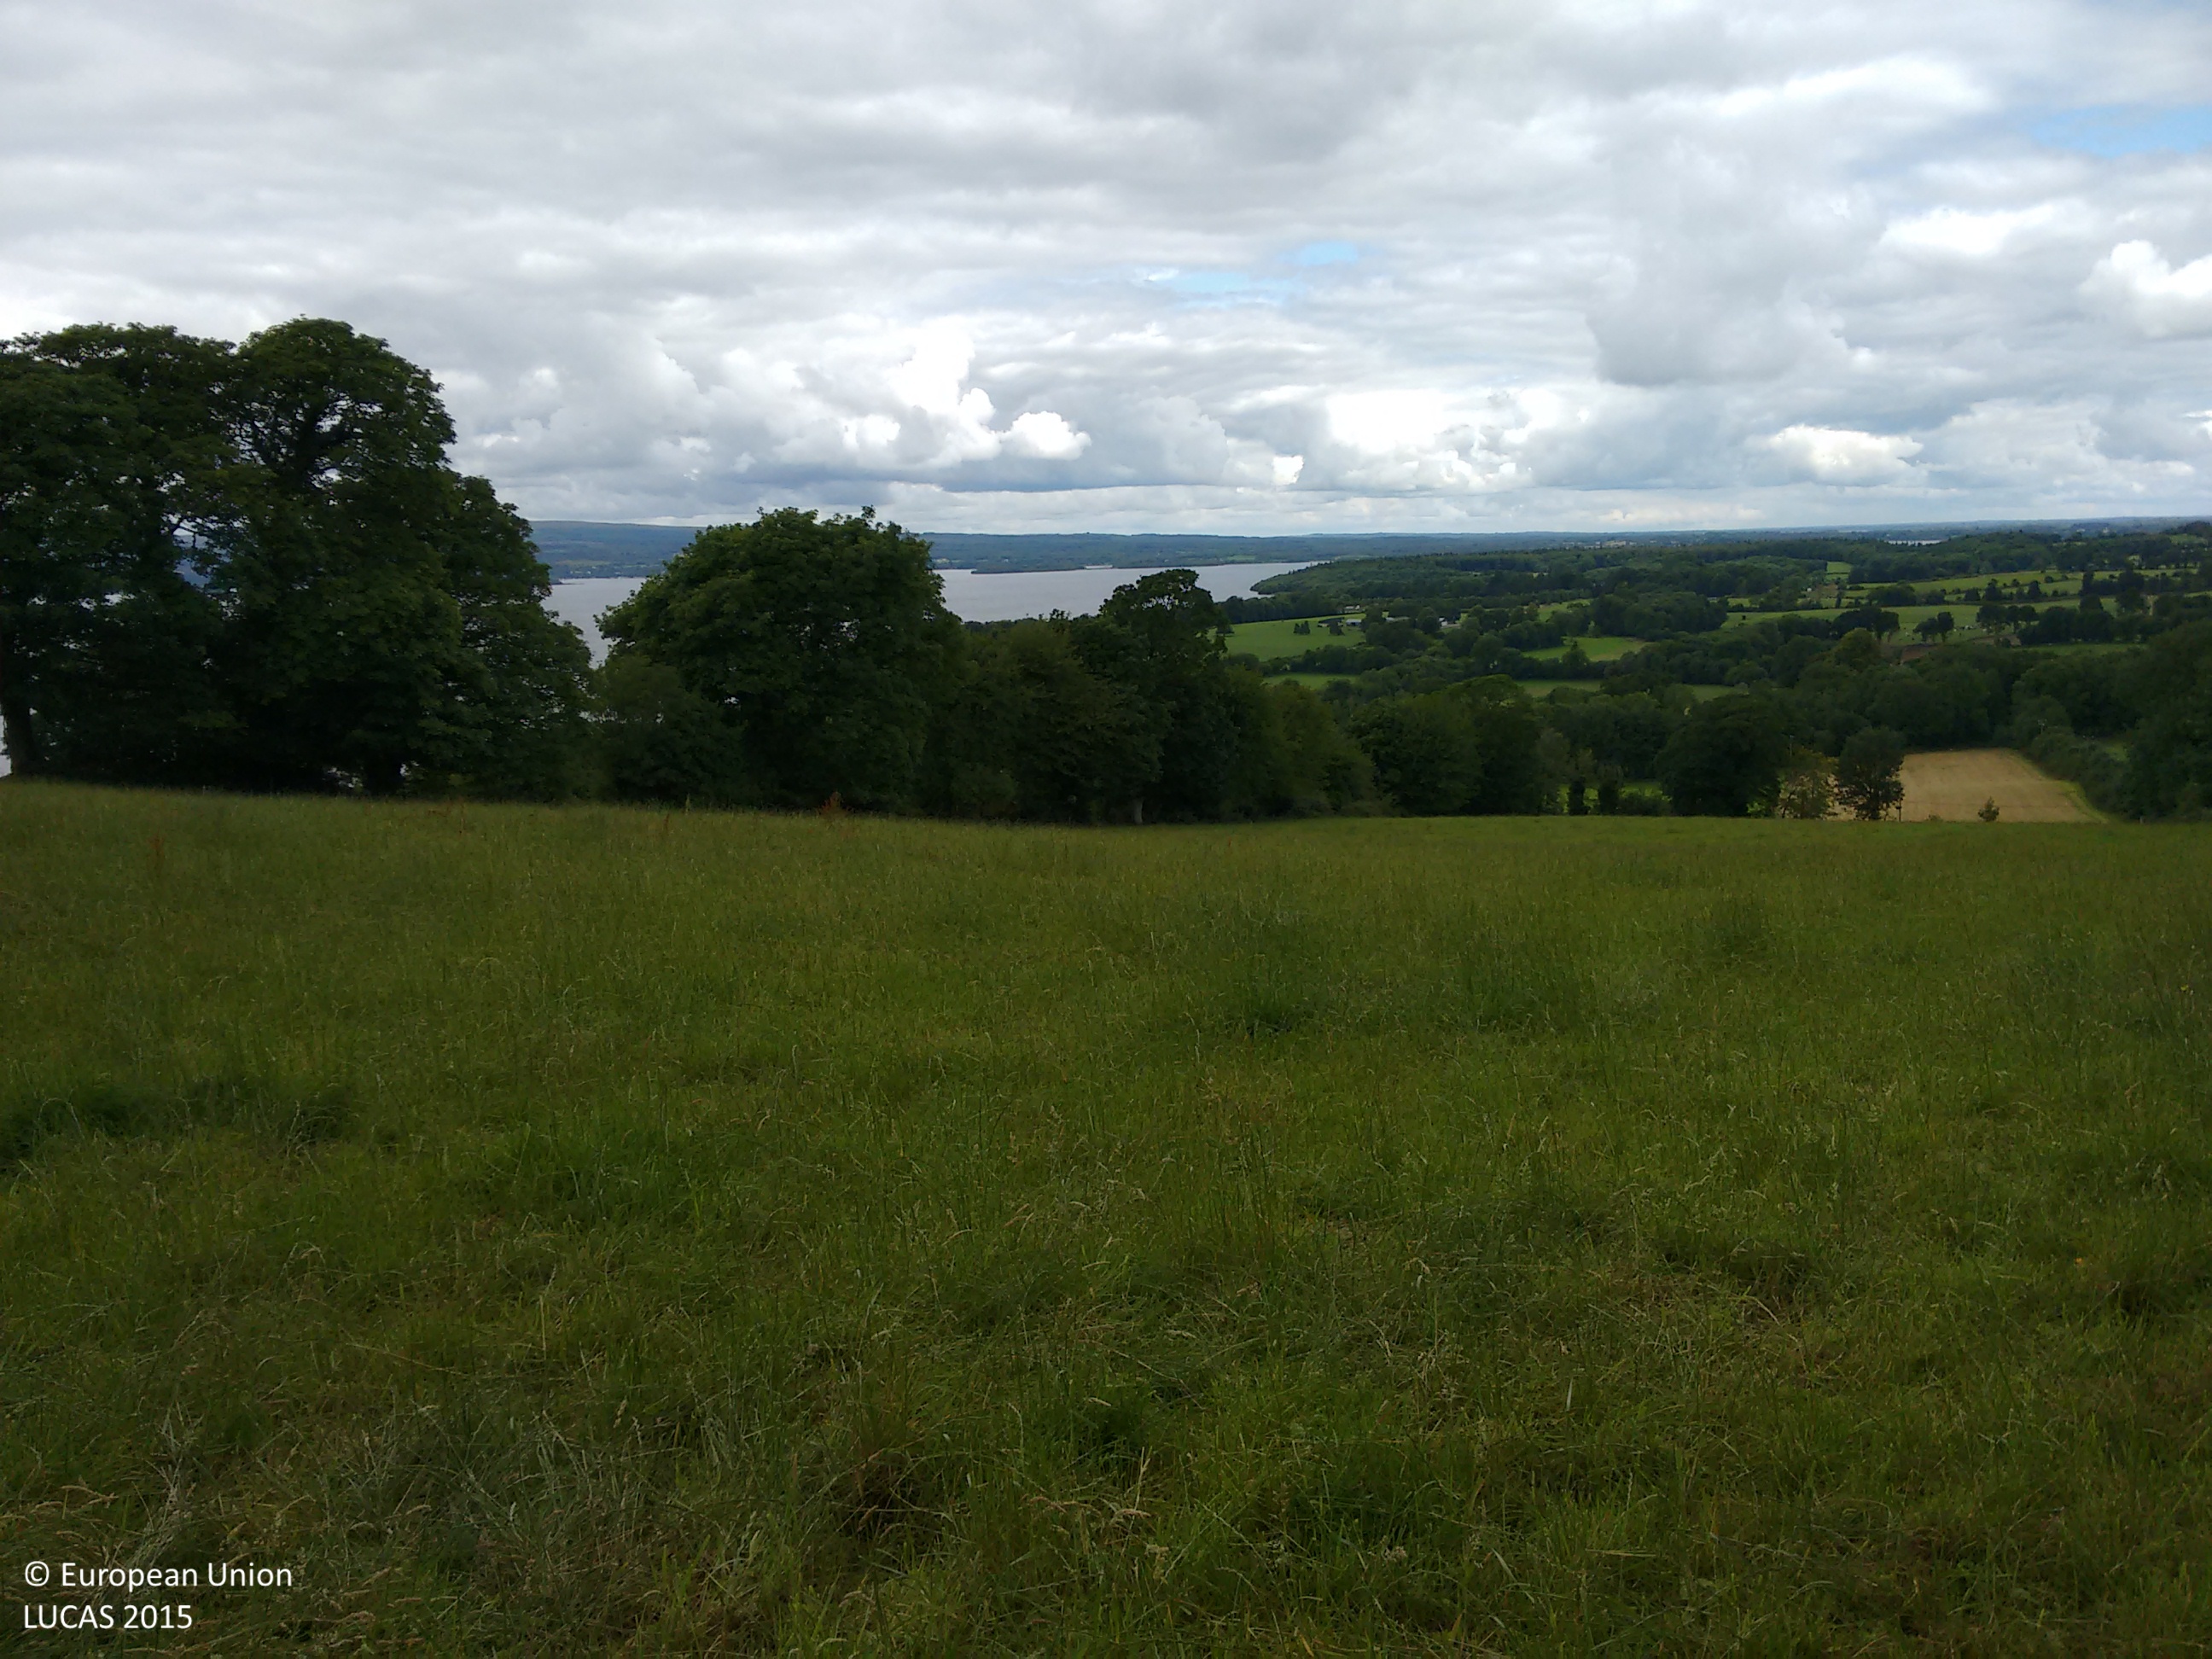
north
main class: Shrubland
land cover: Shrubland with sparse tree cover
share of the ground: > 75 %
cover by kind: shrubs 70 %, herbaceous plants 15 %, lichens and mosses 10 %, broadleaved forest trees 5 %
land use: Semi-natural and natural areas not in use
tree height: > 5 m
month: July
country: IE
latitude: 52.8798
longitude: -8.3925
